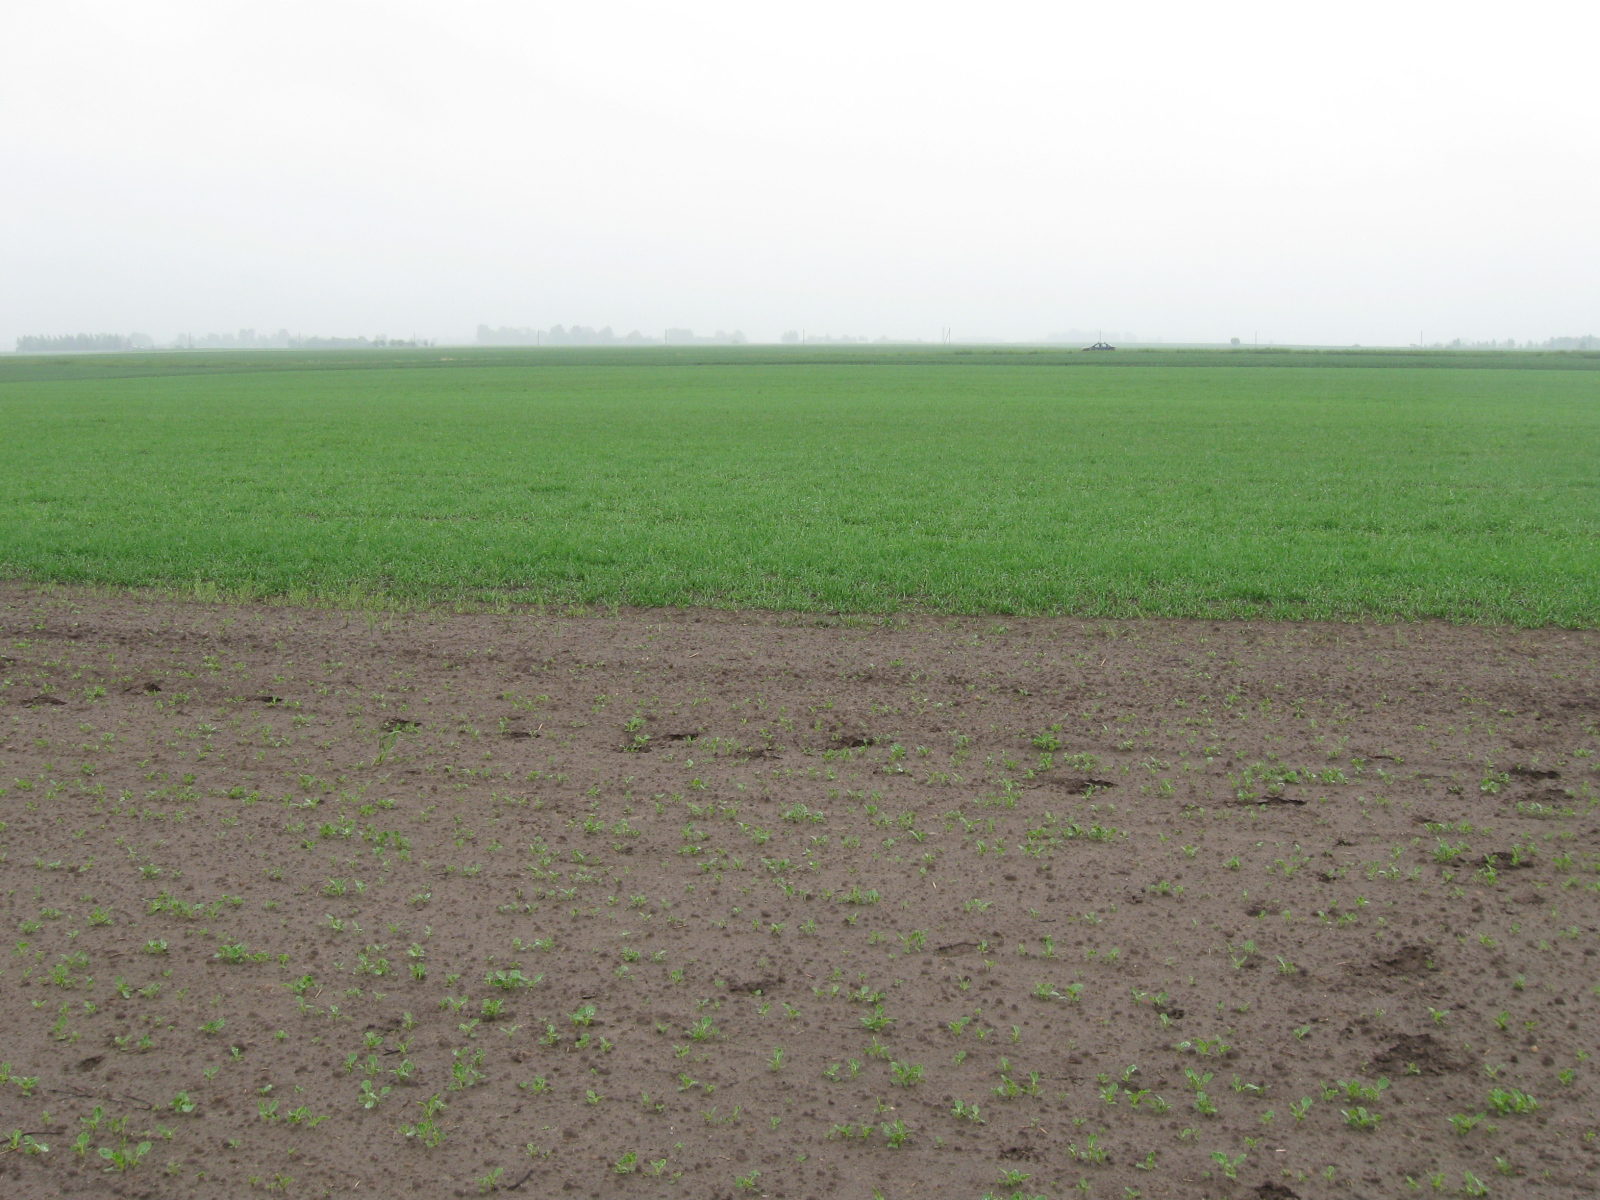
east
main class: Cropland
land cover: Rape and turnip rape
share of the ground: < 10 %
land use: Agriculture (excluding fallow land and kitchen gardens)
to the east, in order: Rape and turnip rape; Barley; Triticale; Grass margins; Tracks; Grass margins; Common wheat
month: May
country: LT
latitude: 55.0519
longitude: 22.7934
